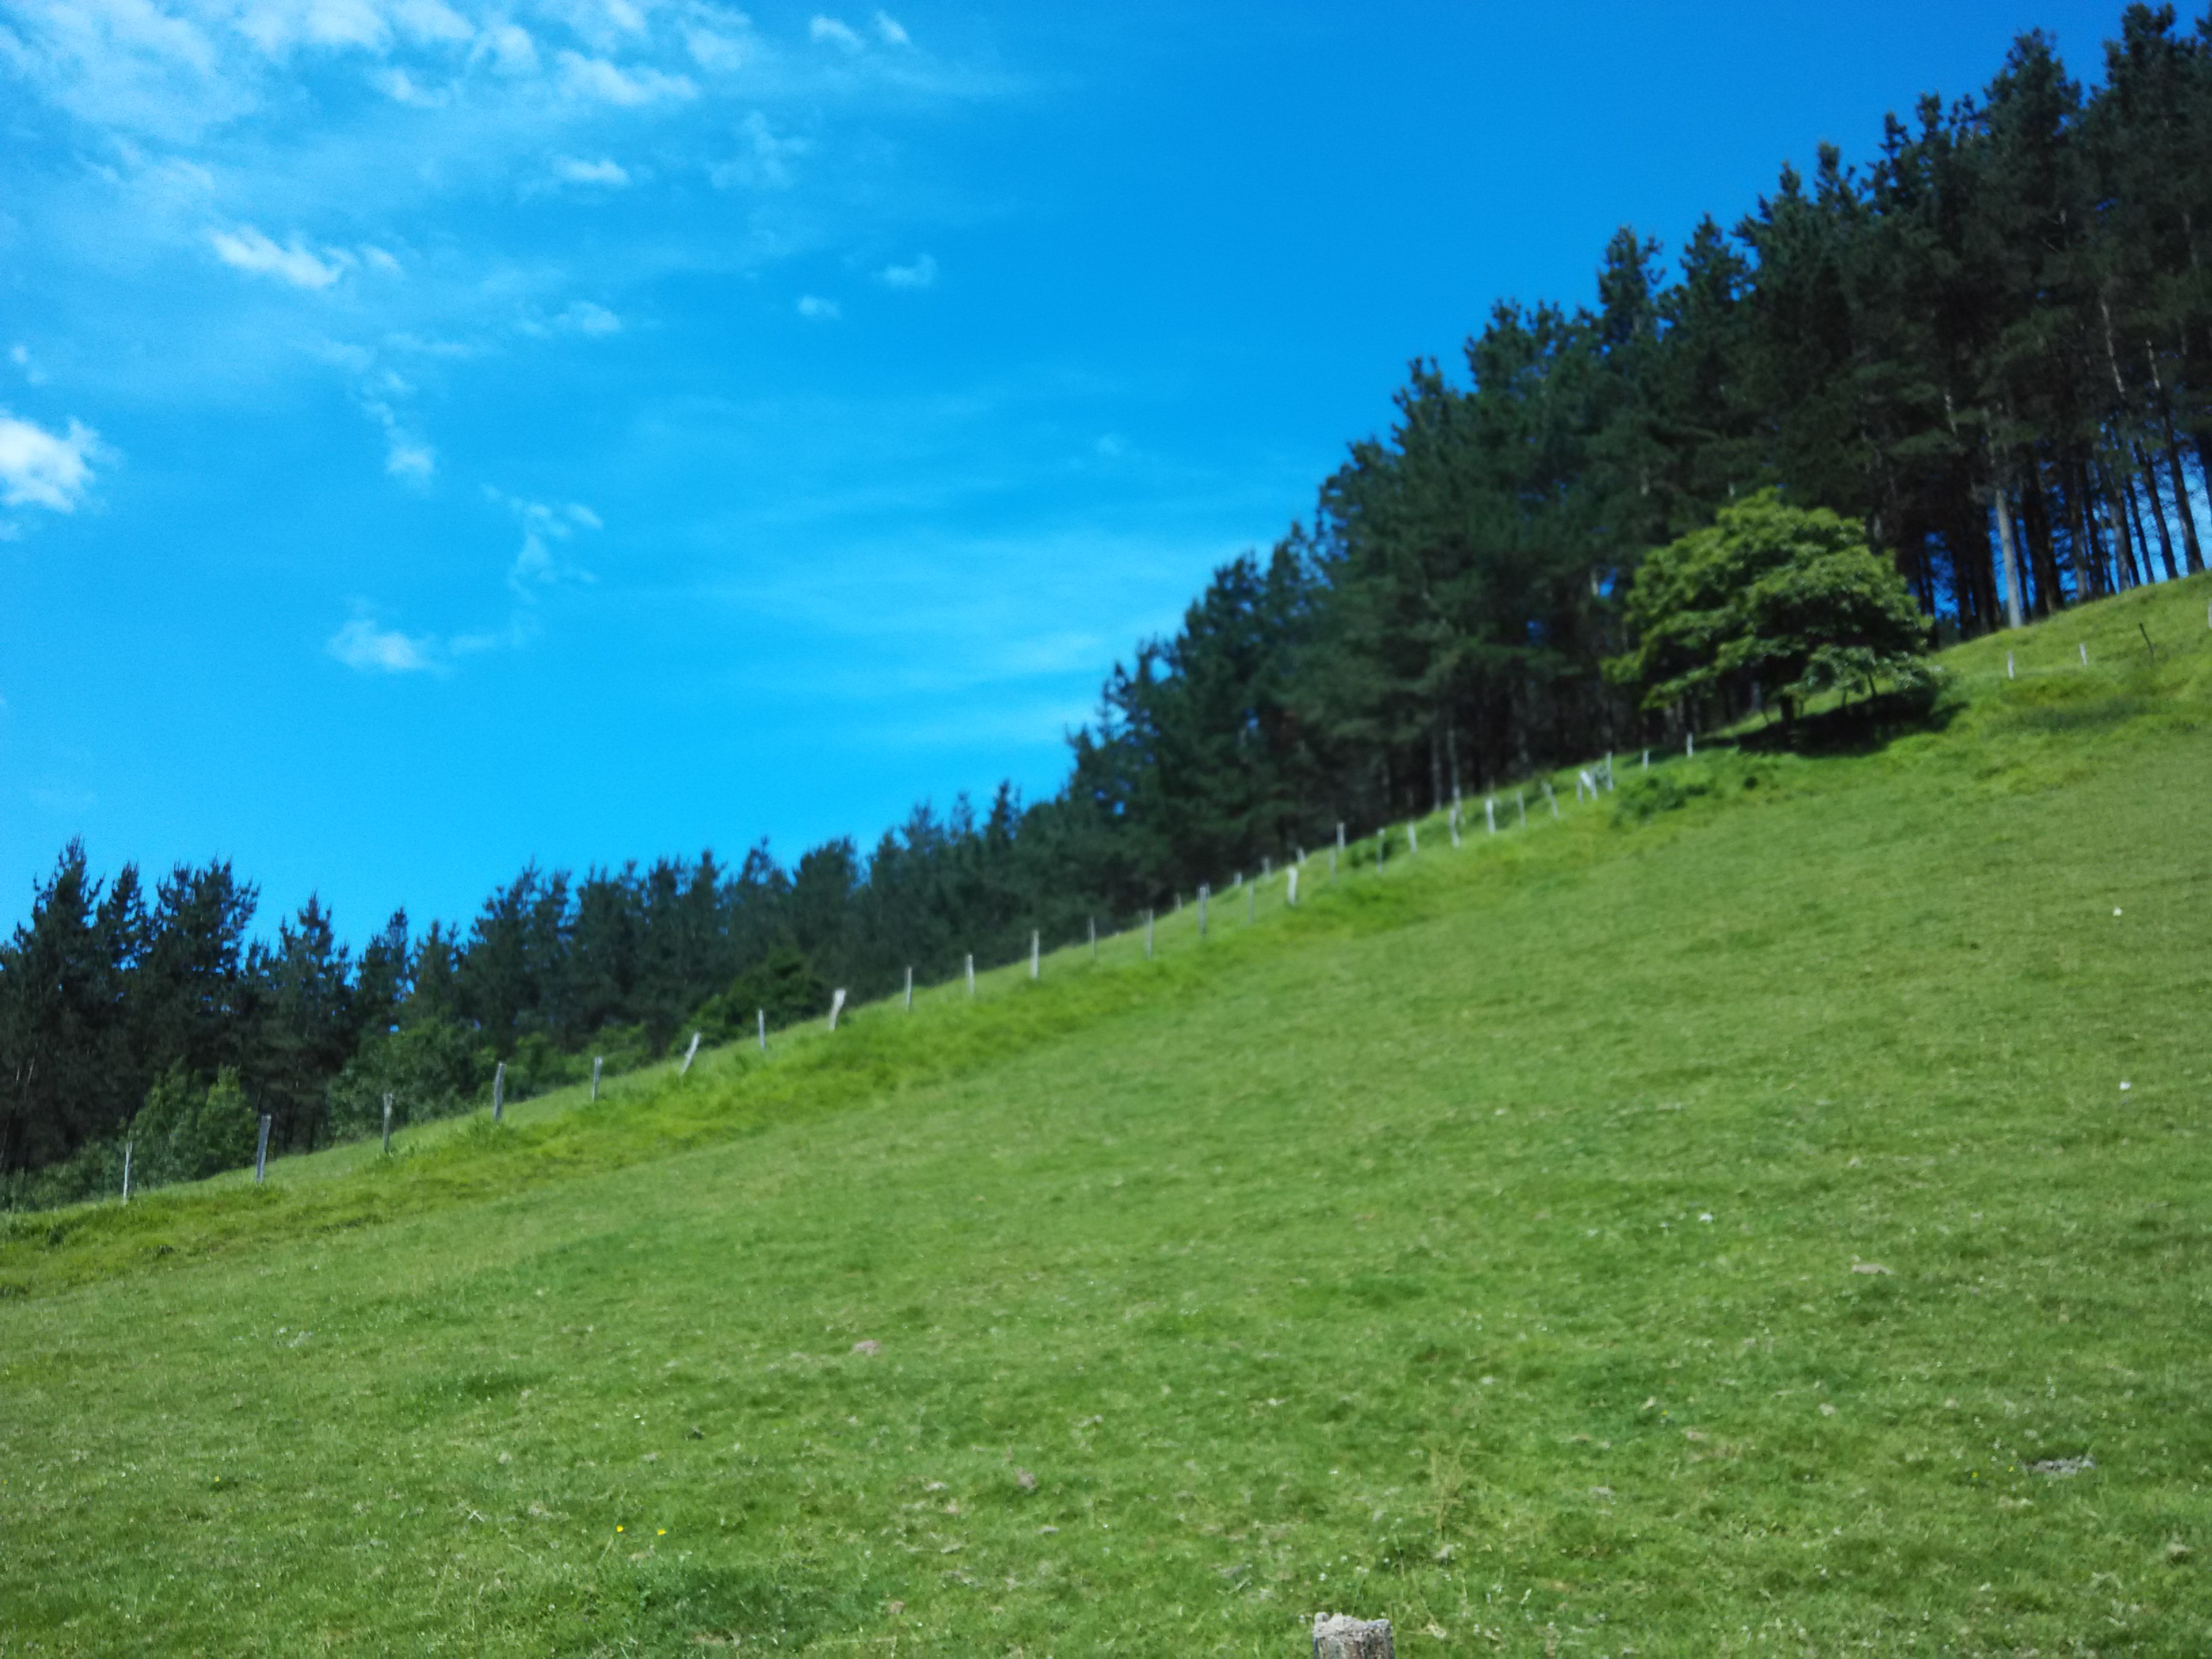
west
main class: Grassland
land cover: Grassland without tree/shrub cover
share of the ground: > 75 %
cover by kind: herbaceous plants 100 %
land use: Agriculture (excluding fallow land and kitchen gardens)
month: June
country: ES
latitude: 43.2267
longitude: -2.5002
